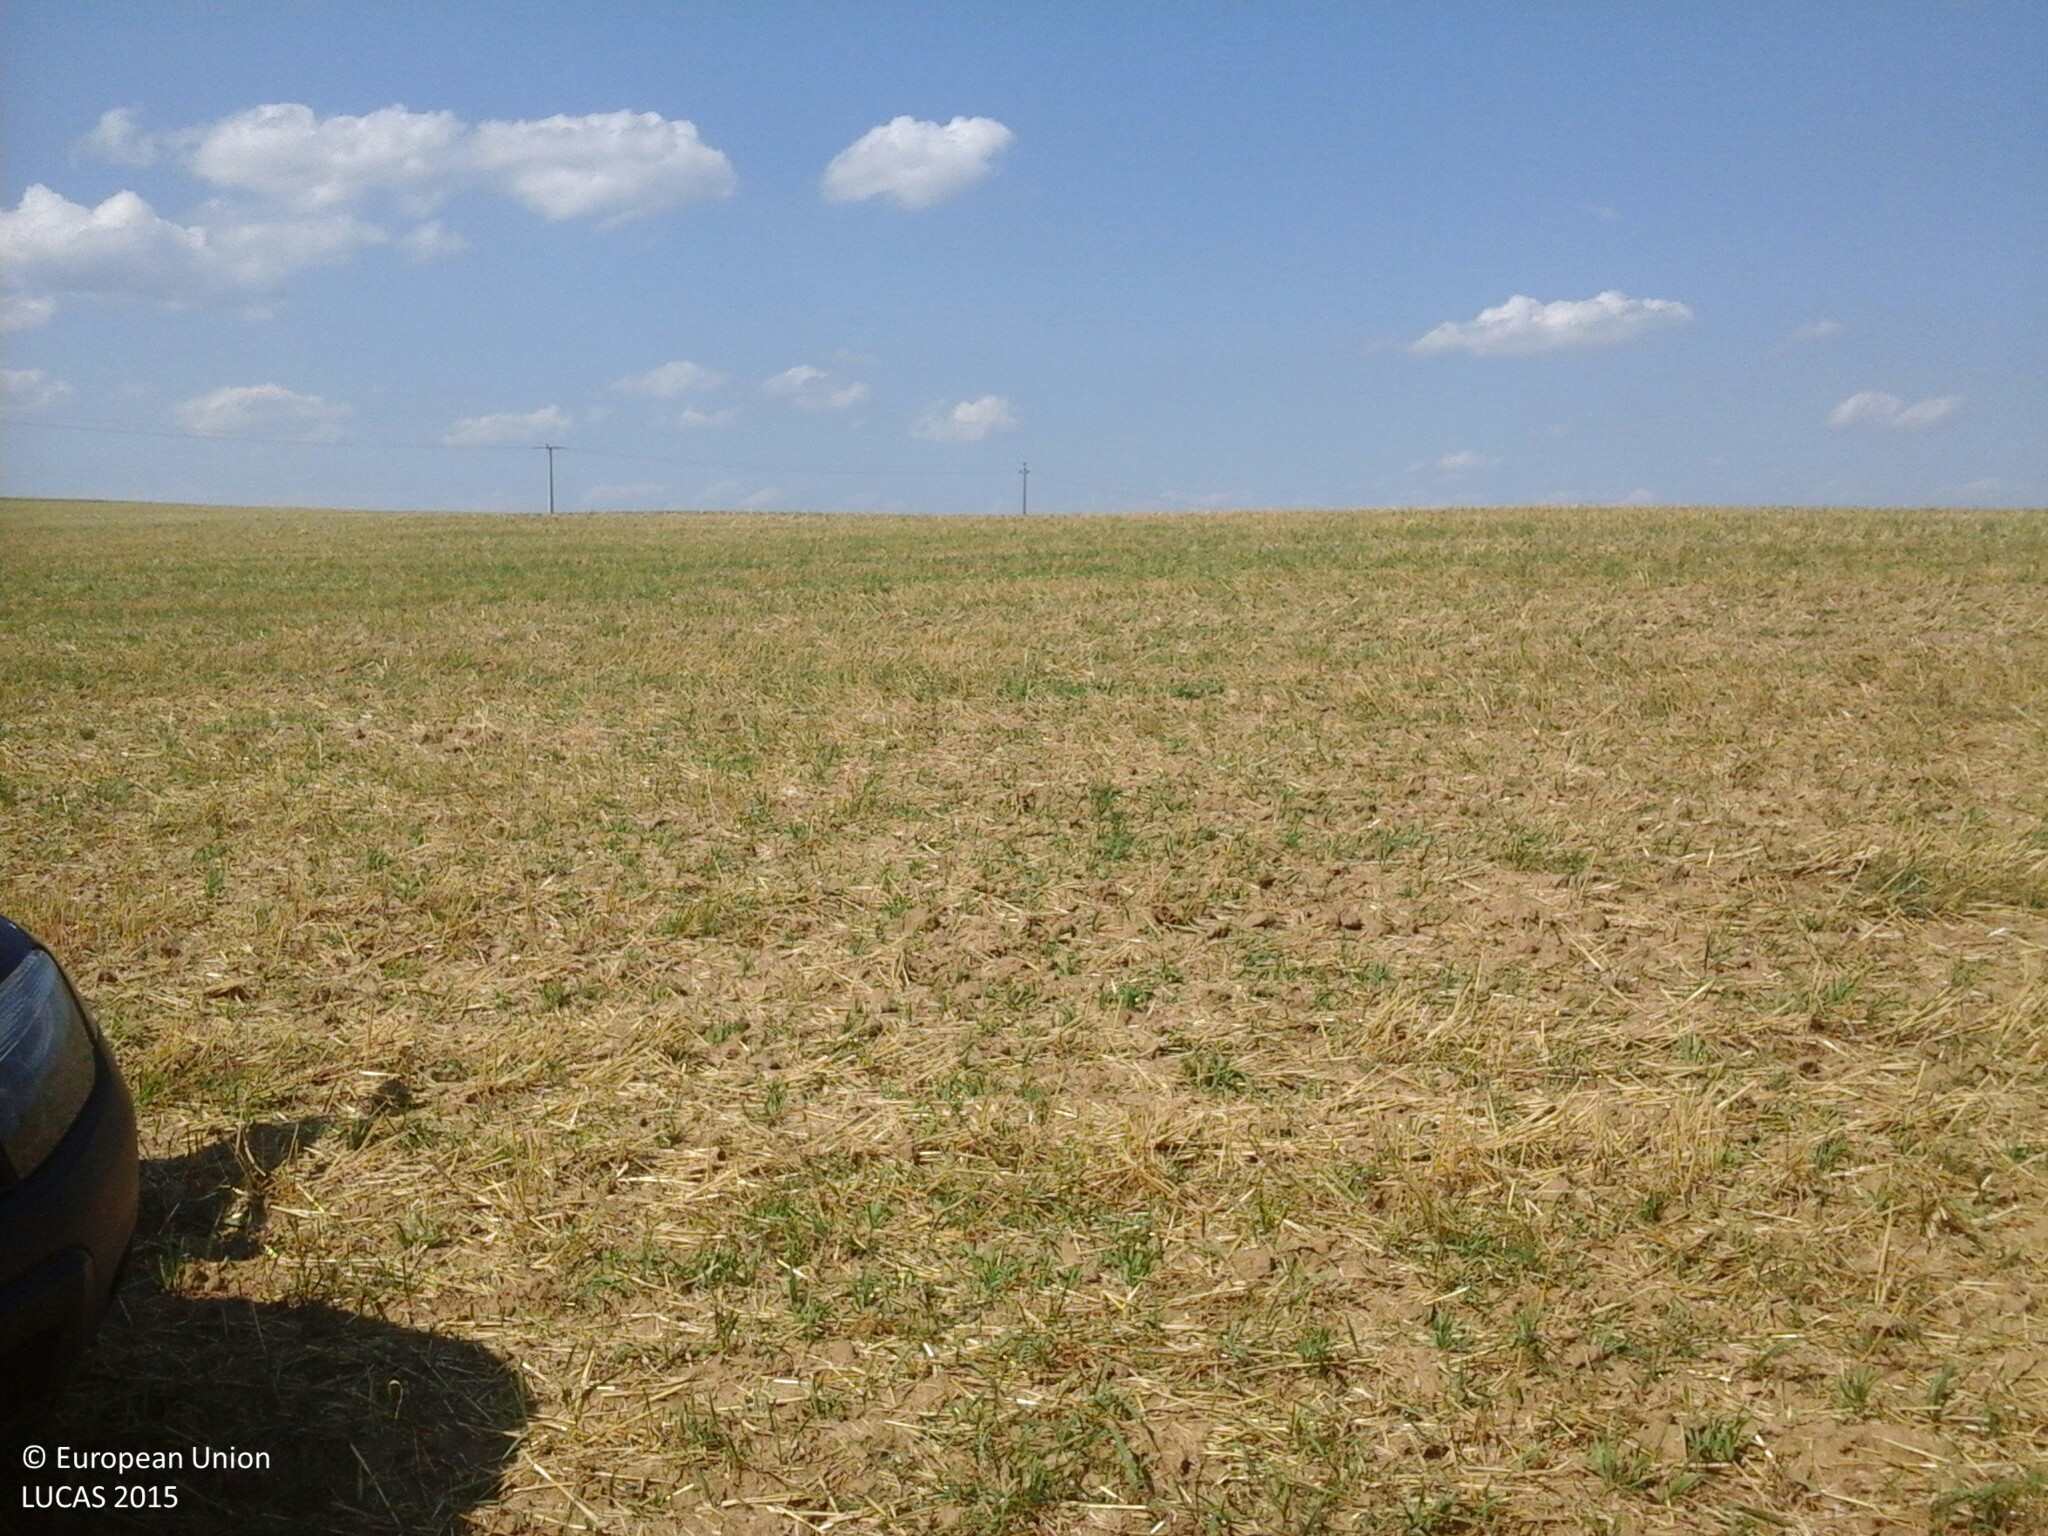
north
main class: Cropland
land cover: Barley
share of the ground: > 75 %
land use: Agriculture (excluding fallow land and kitchen gardens)
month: July
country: HU
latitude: 47.2688
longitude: 17.9268
